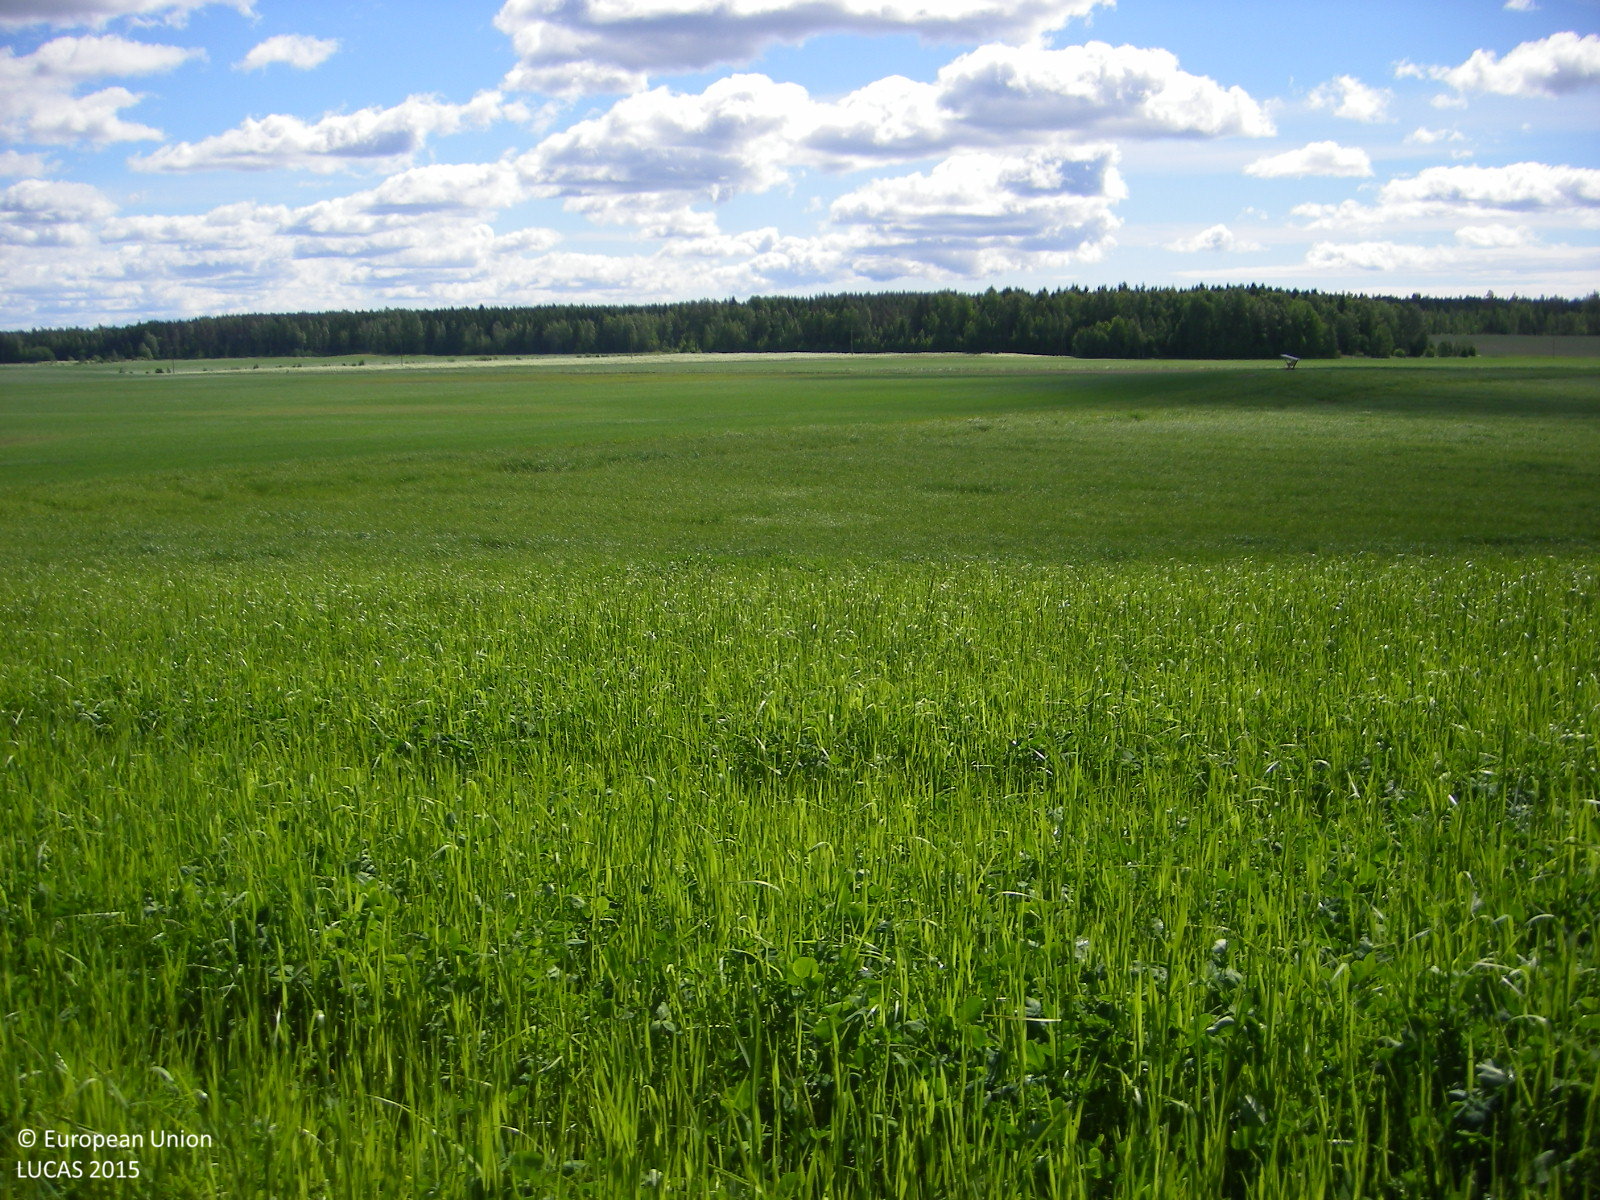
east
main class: Cropland
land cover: Other leguminous and mixtures for fodder
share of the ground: > 75 %
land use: Agriculture (excluding fallow land and kitchen gardens)
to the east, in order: Other leguminous and mixtures for fodder; Common wheat; Ditches and canals; Common wheat
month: June
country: FI
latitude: 60.1427
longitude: 24.1292
